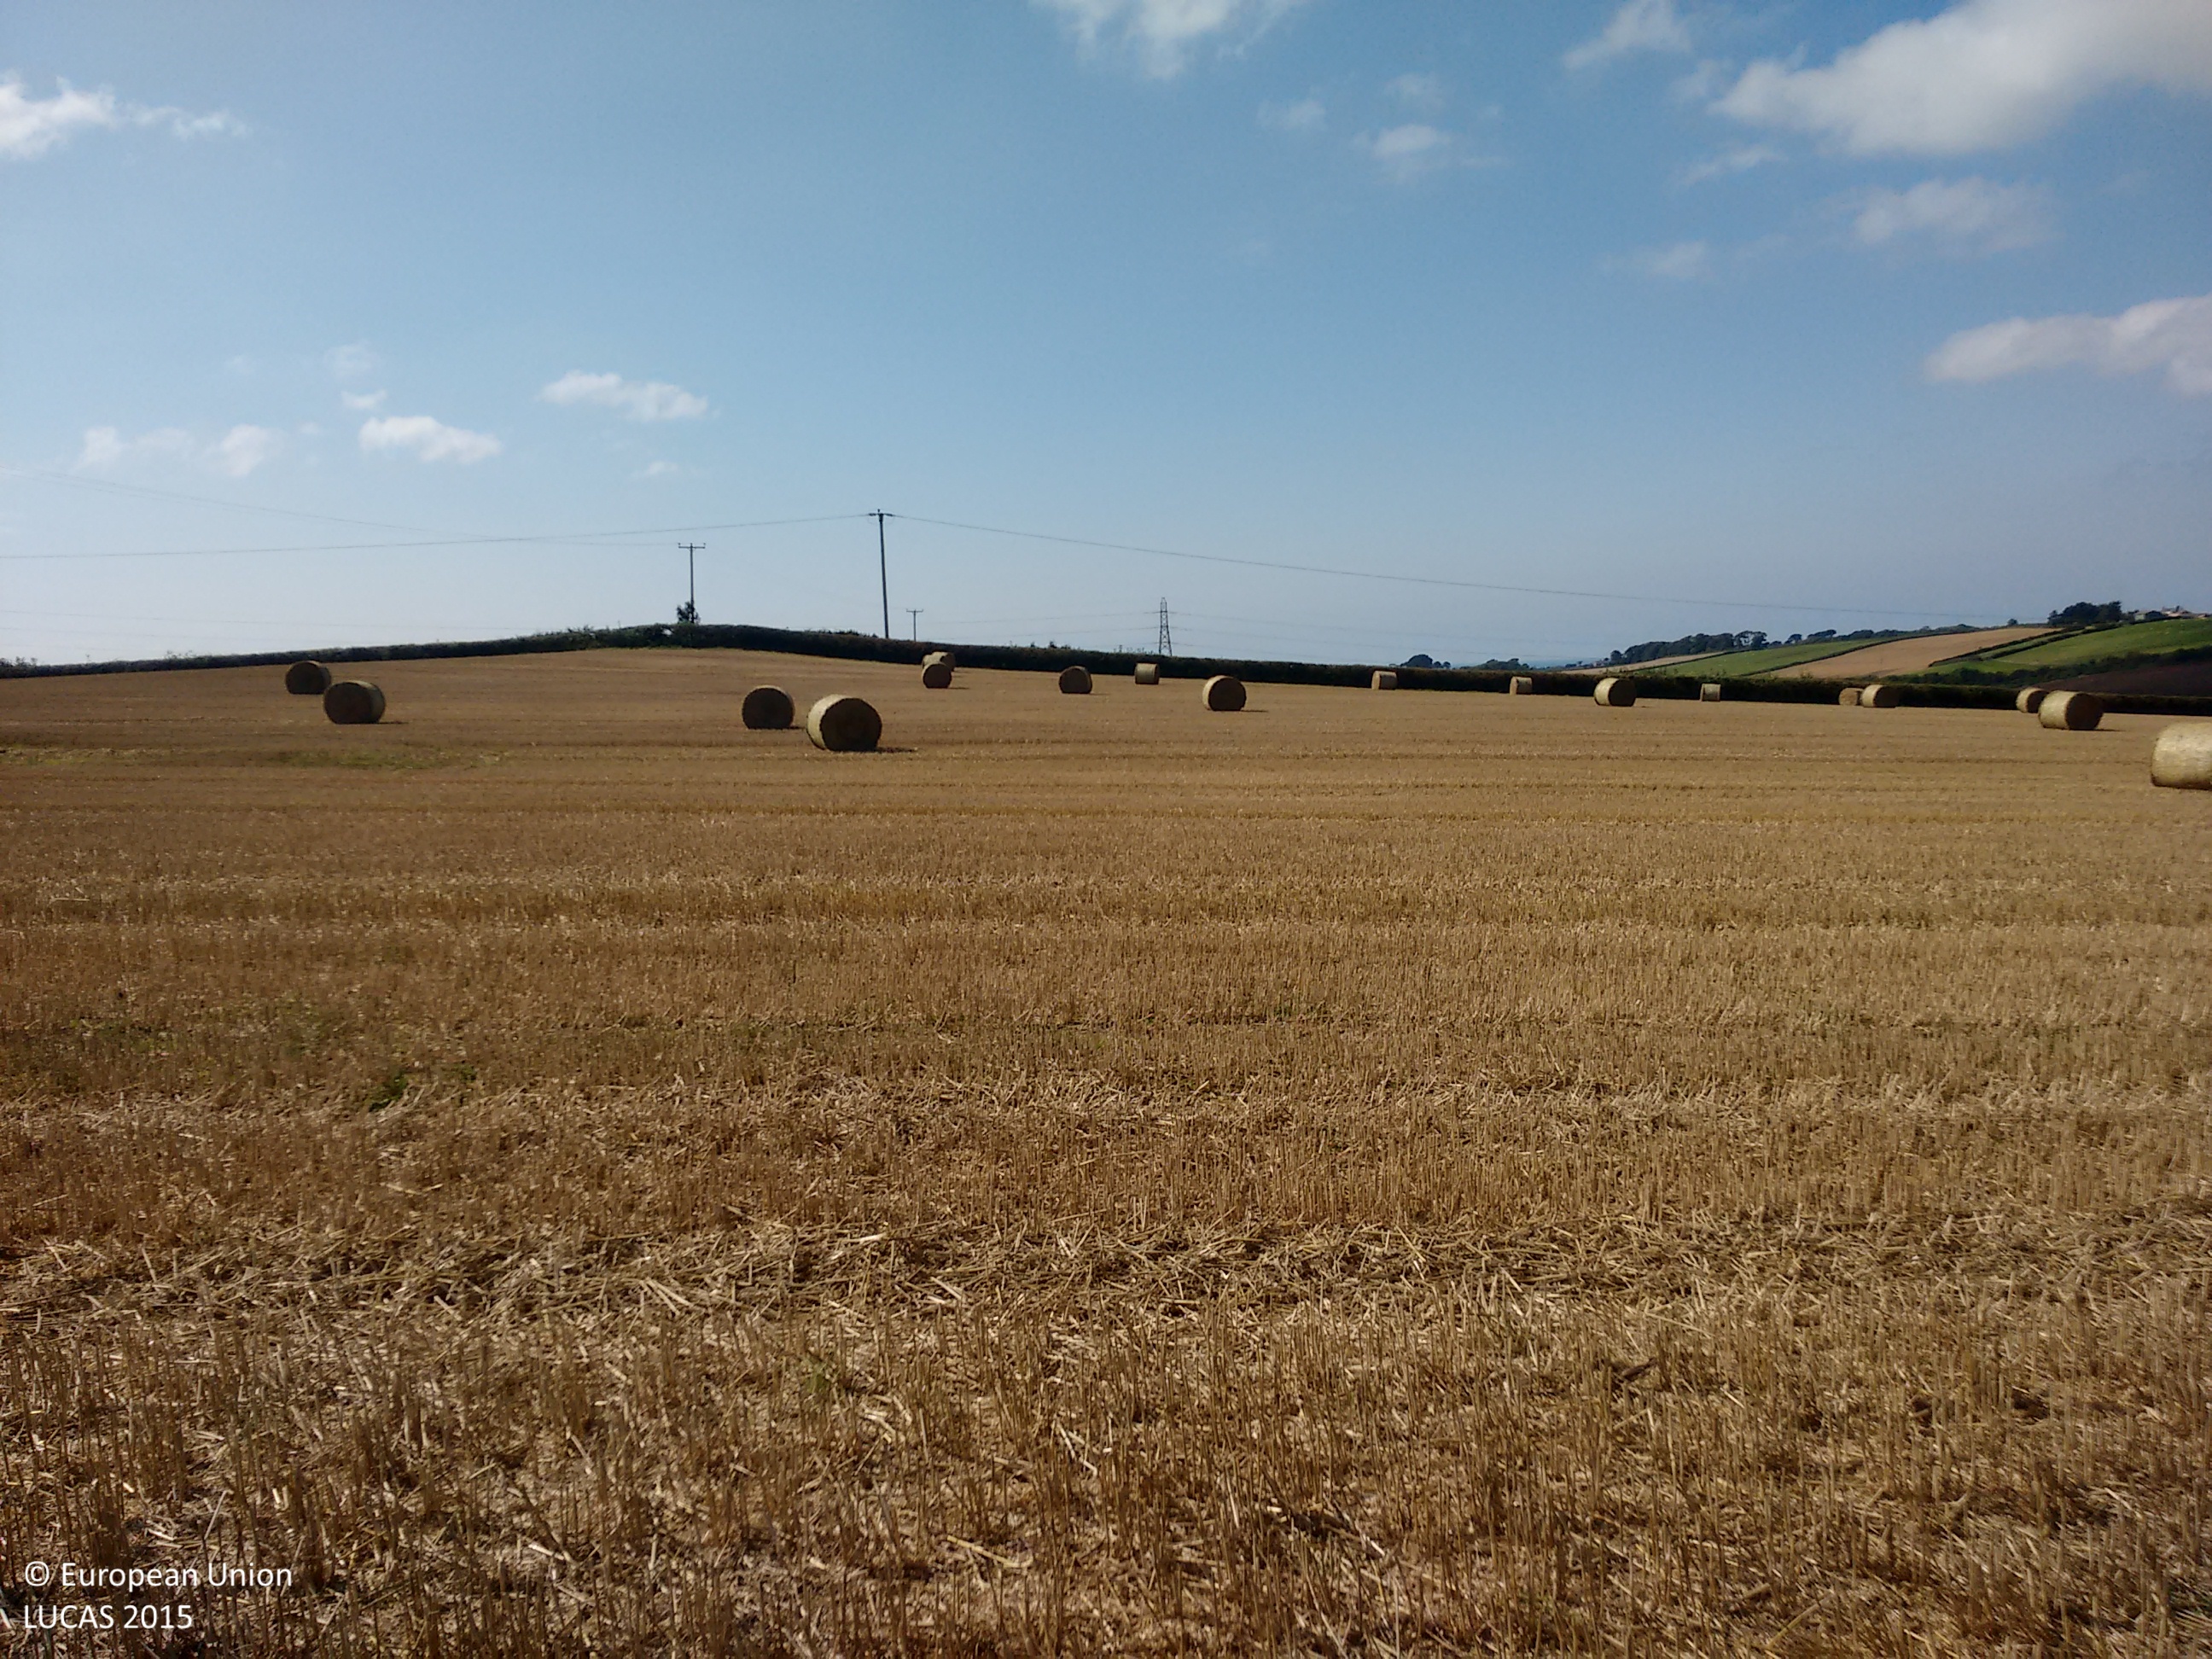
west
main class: Cropland
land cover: Barley
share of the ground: < 10 %
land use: Agriculture (excluding fallow land and kitchen gardens)
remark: Harvested field
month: September
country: GB
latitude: 51.0318
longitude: -4.1429
